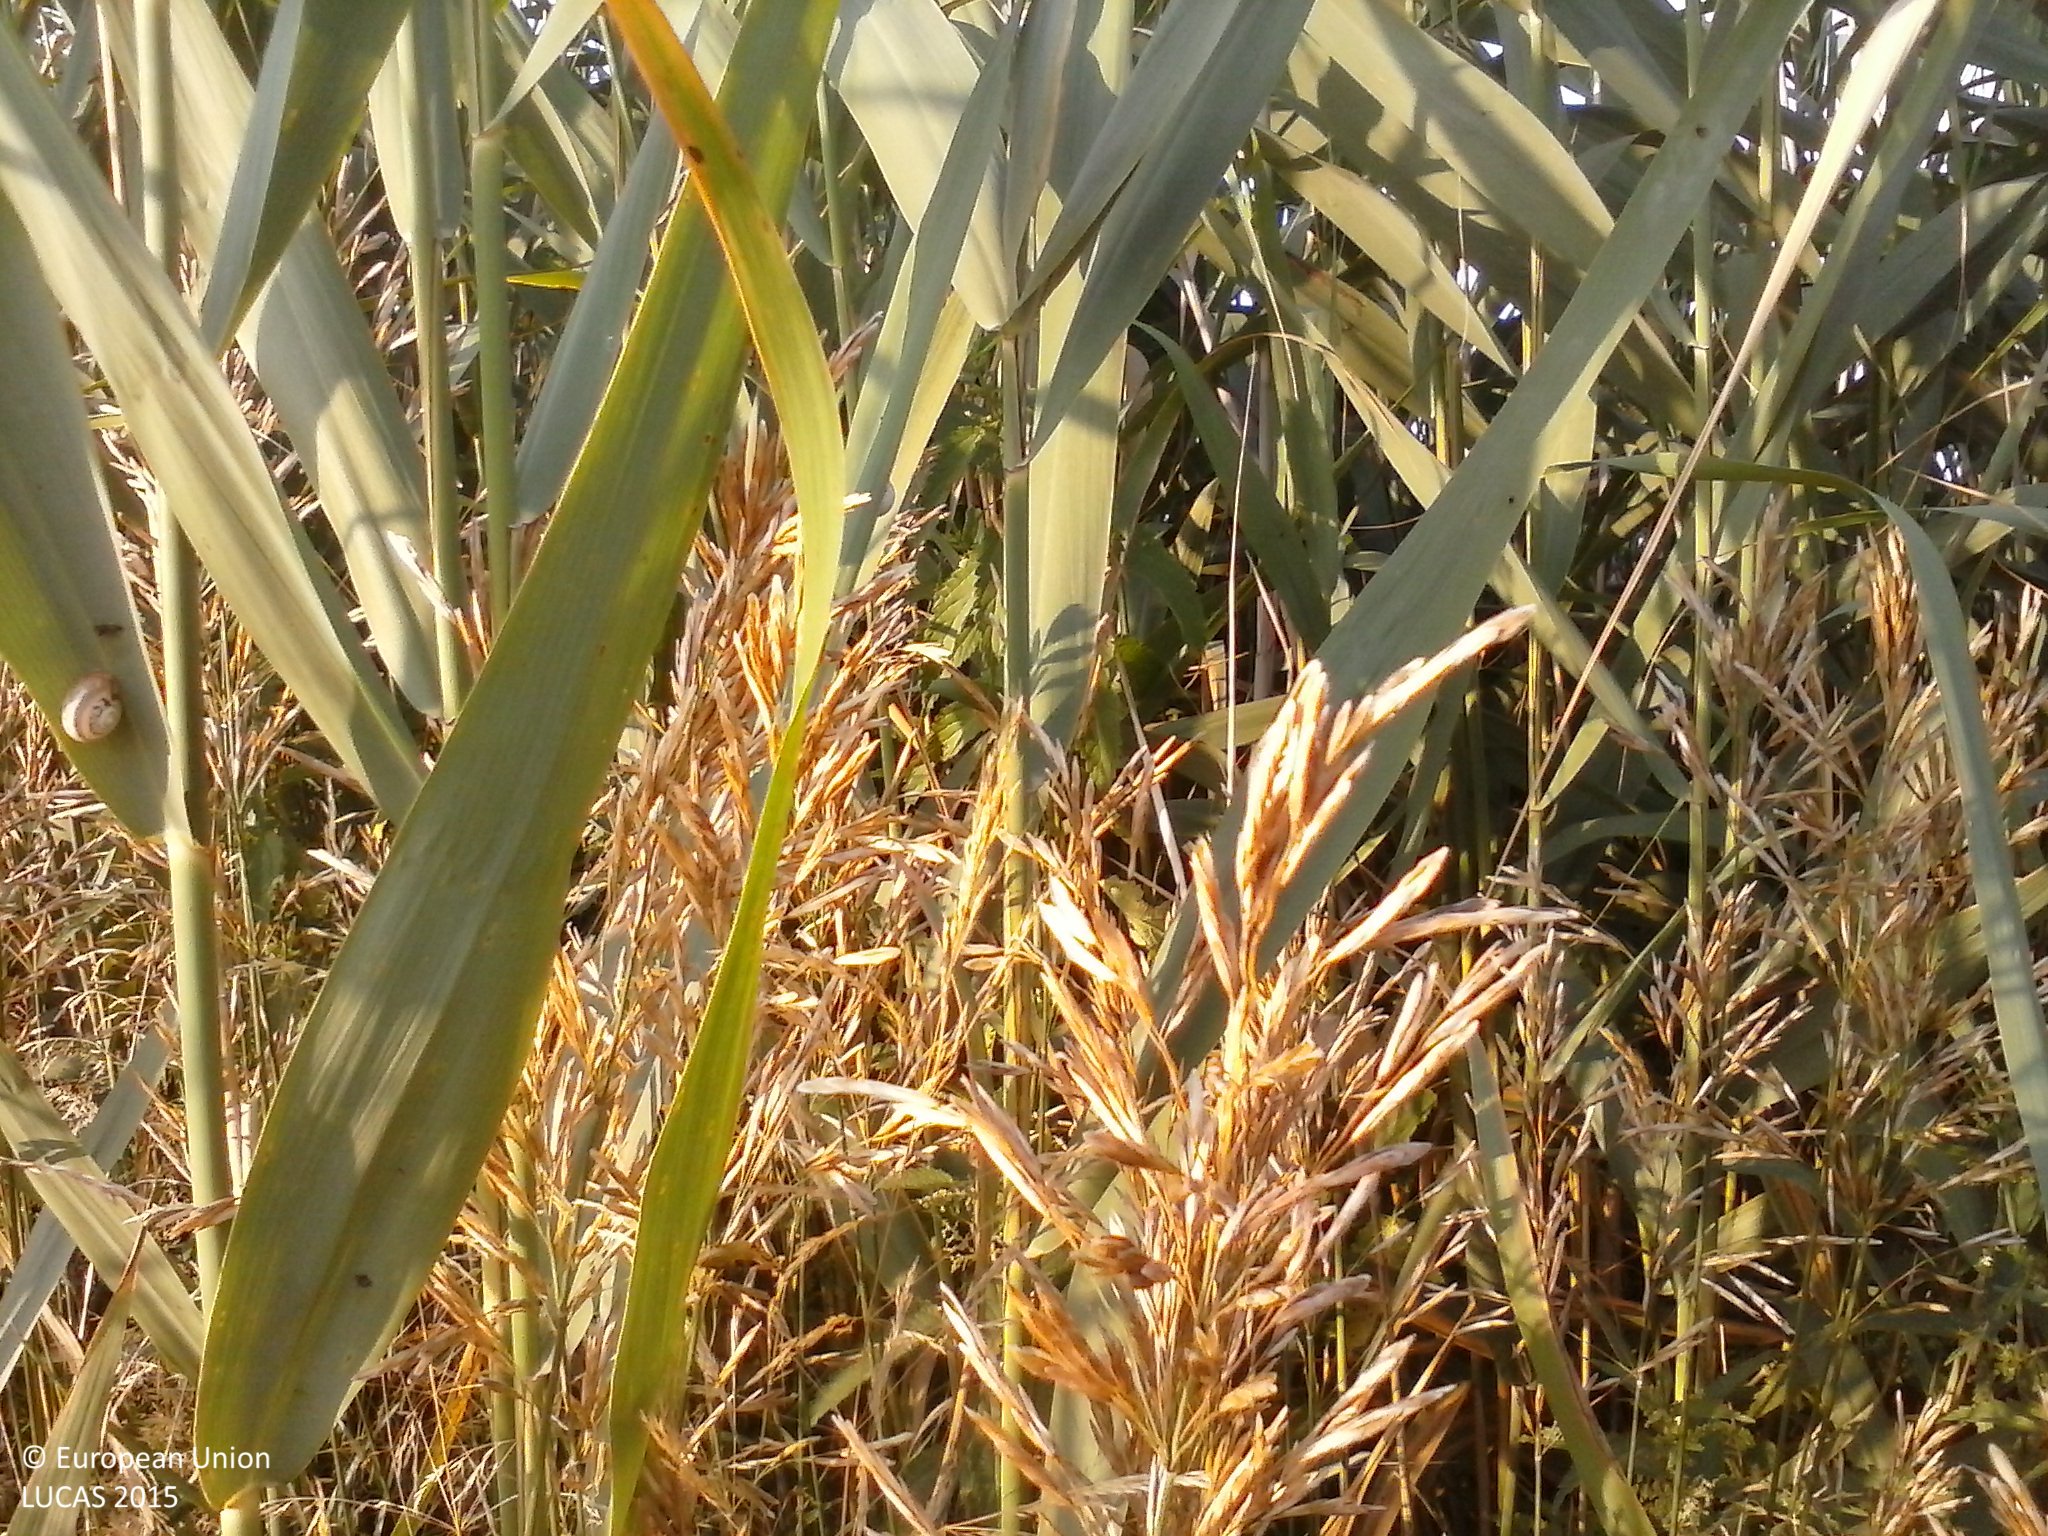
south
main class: Cropland
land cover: Rape and turnip rape
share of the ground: 10 - 25 %
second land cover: Spontaneously vegetated surfaces
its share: > 75 %
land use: Agriculture (excluding fallow land and kitchen gardens)
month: July
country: HU
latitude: 46.4324
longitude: 19.5307
